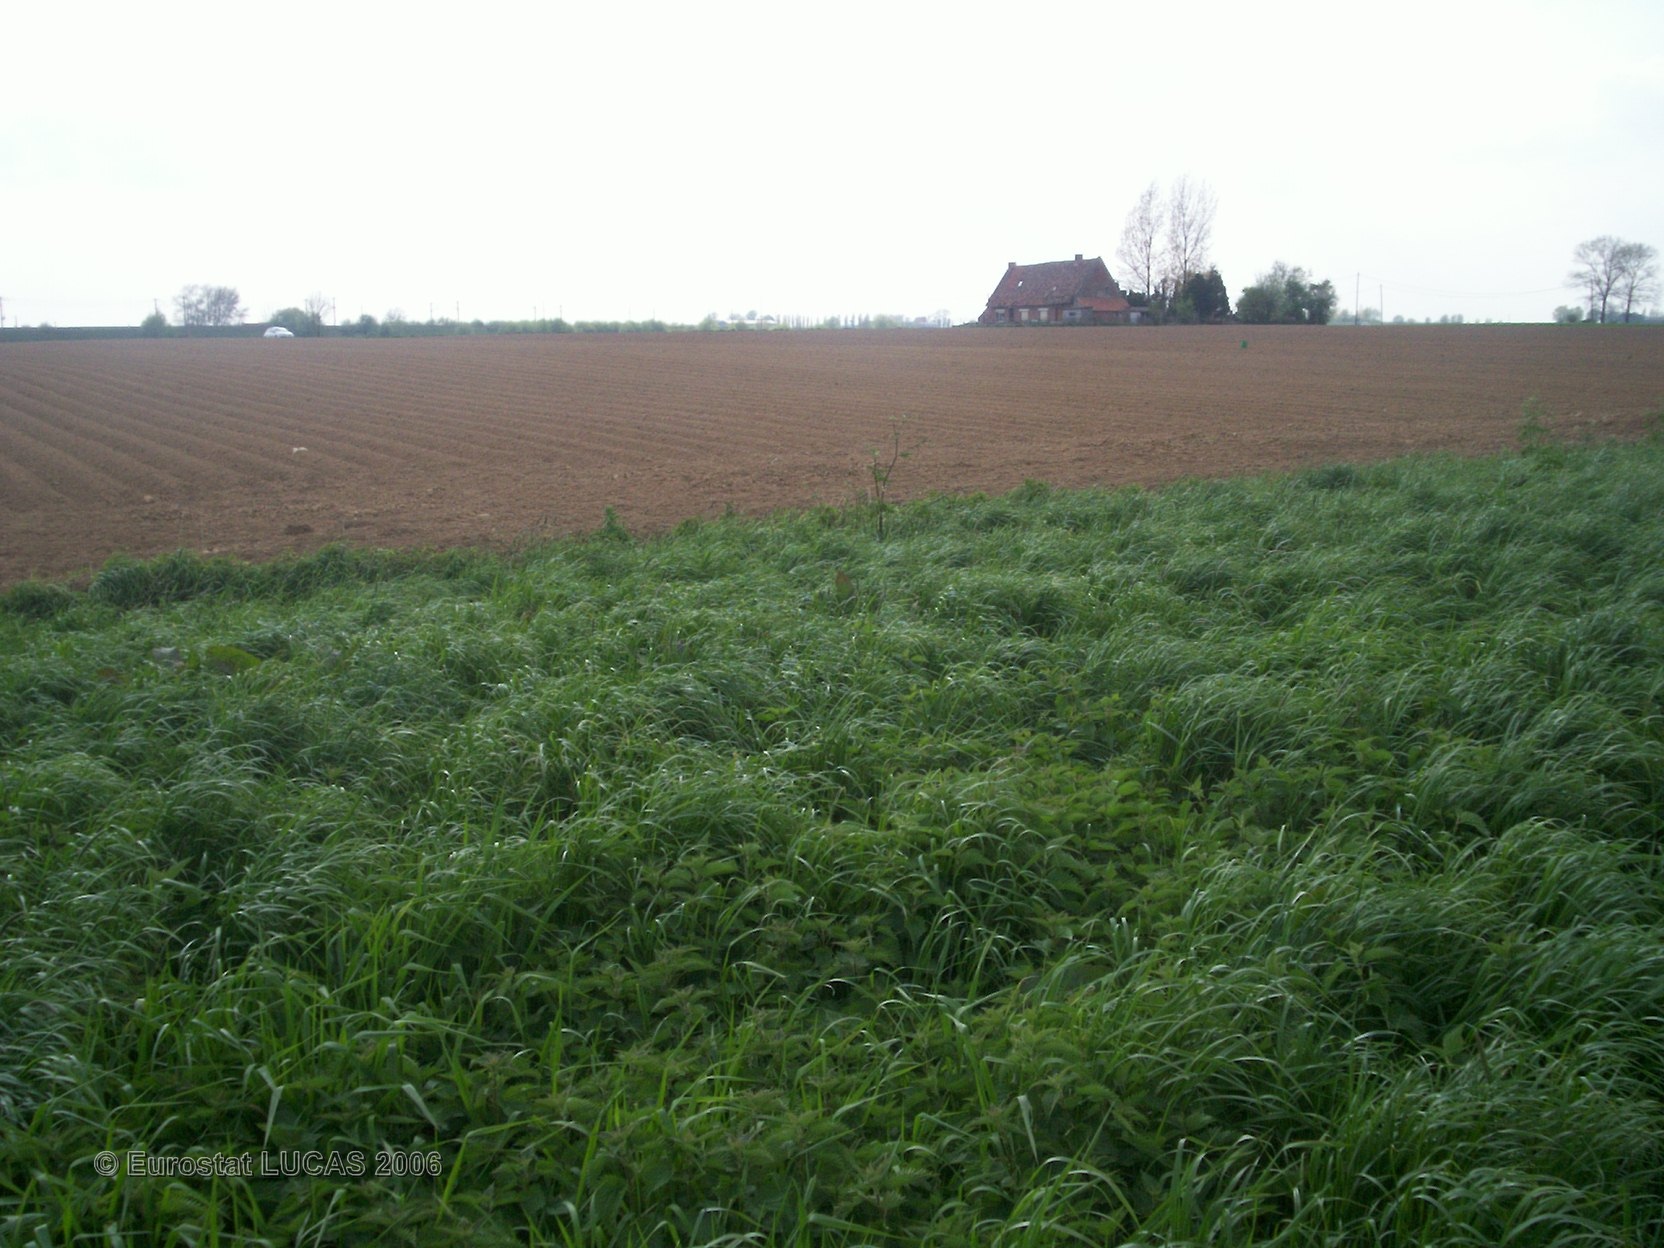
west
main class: Grassland
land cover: Grassland without tree/shrub cover
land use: Agriculture (excluding fallow land and kitchen gardens)
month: May
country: FR
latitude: 50.7546
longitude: 2.5742
